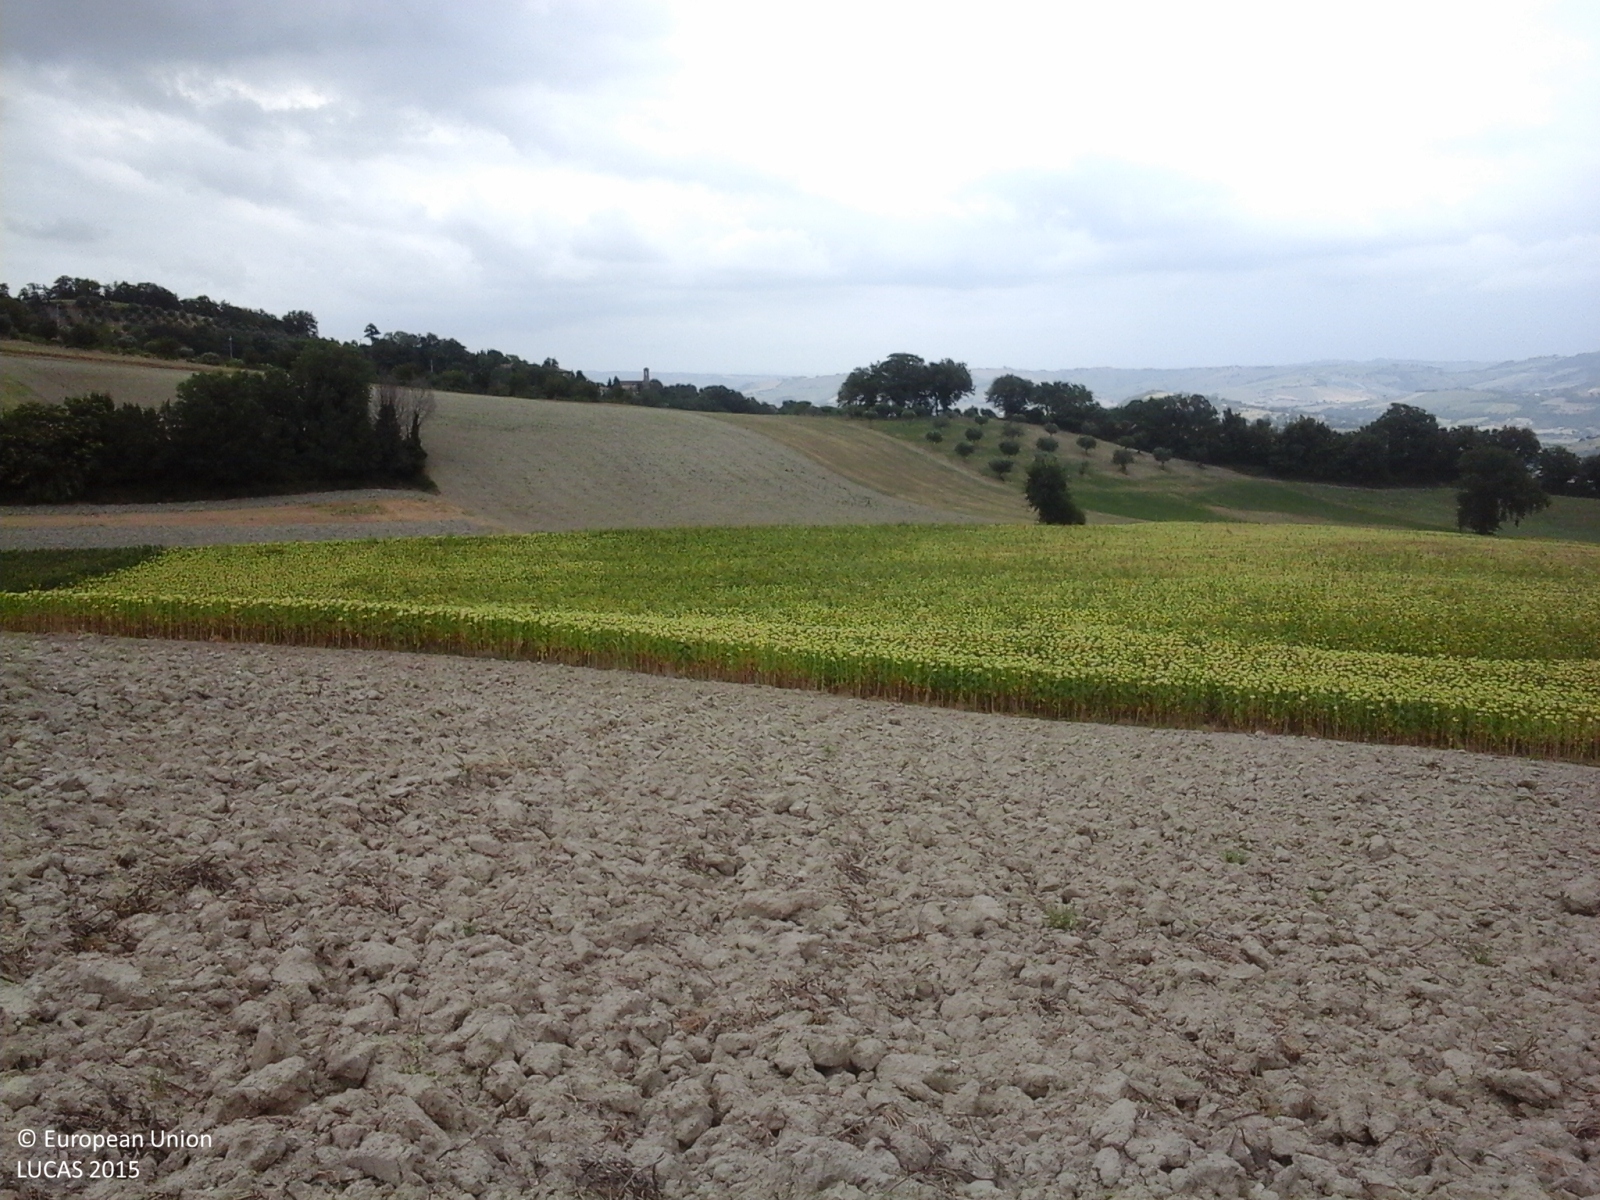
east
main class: Cropland
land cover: Dry pulses
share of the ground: > 75 %
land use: Agriculture (excluding fallow land and kitchen gardens)
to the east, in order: Dry pulses; Sunflower; Dry pulses
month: July
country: IT
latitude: 43.2553
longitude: 13.1573
